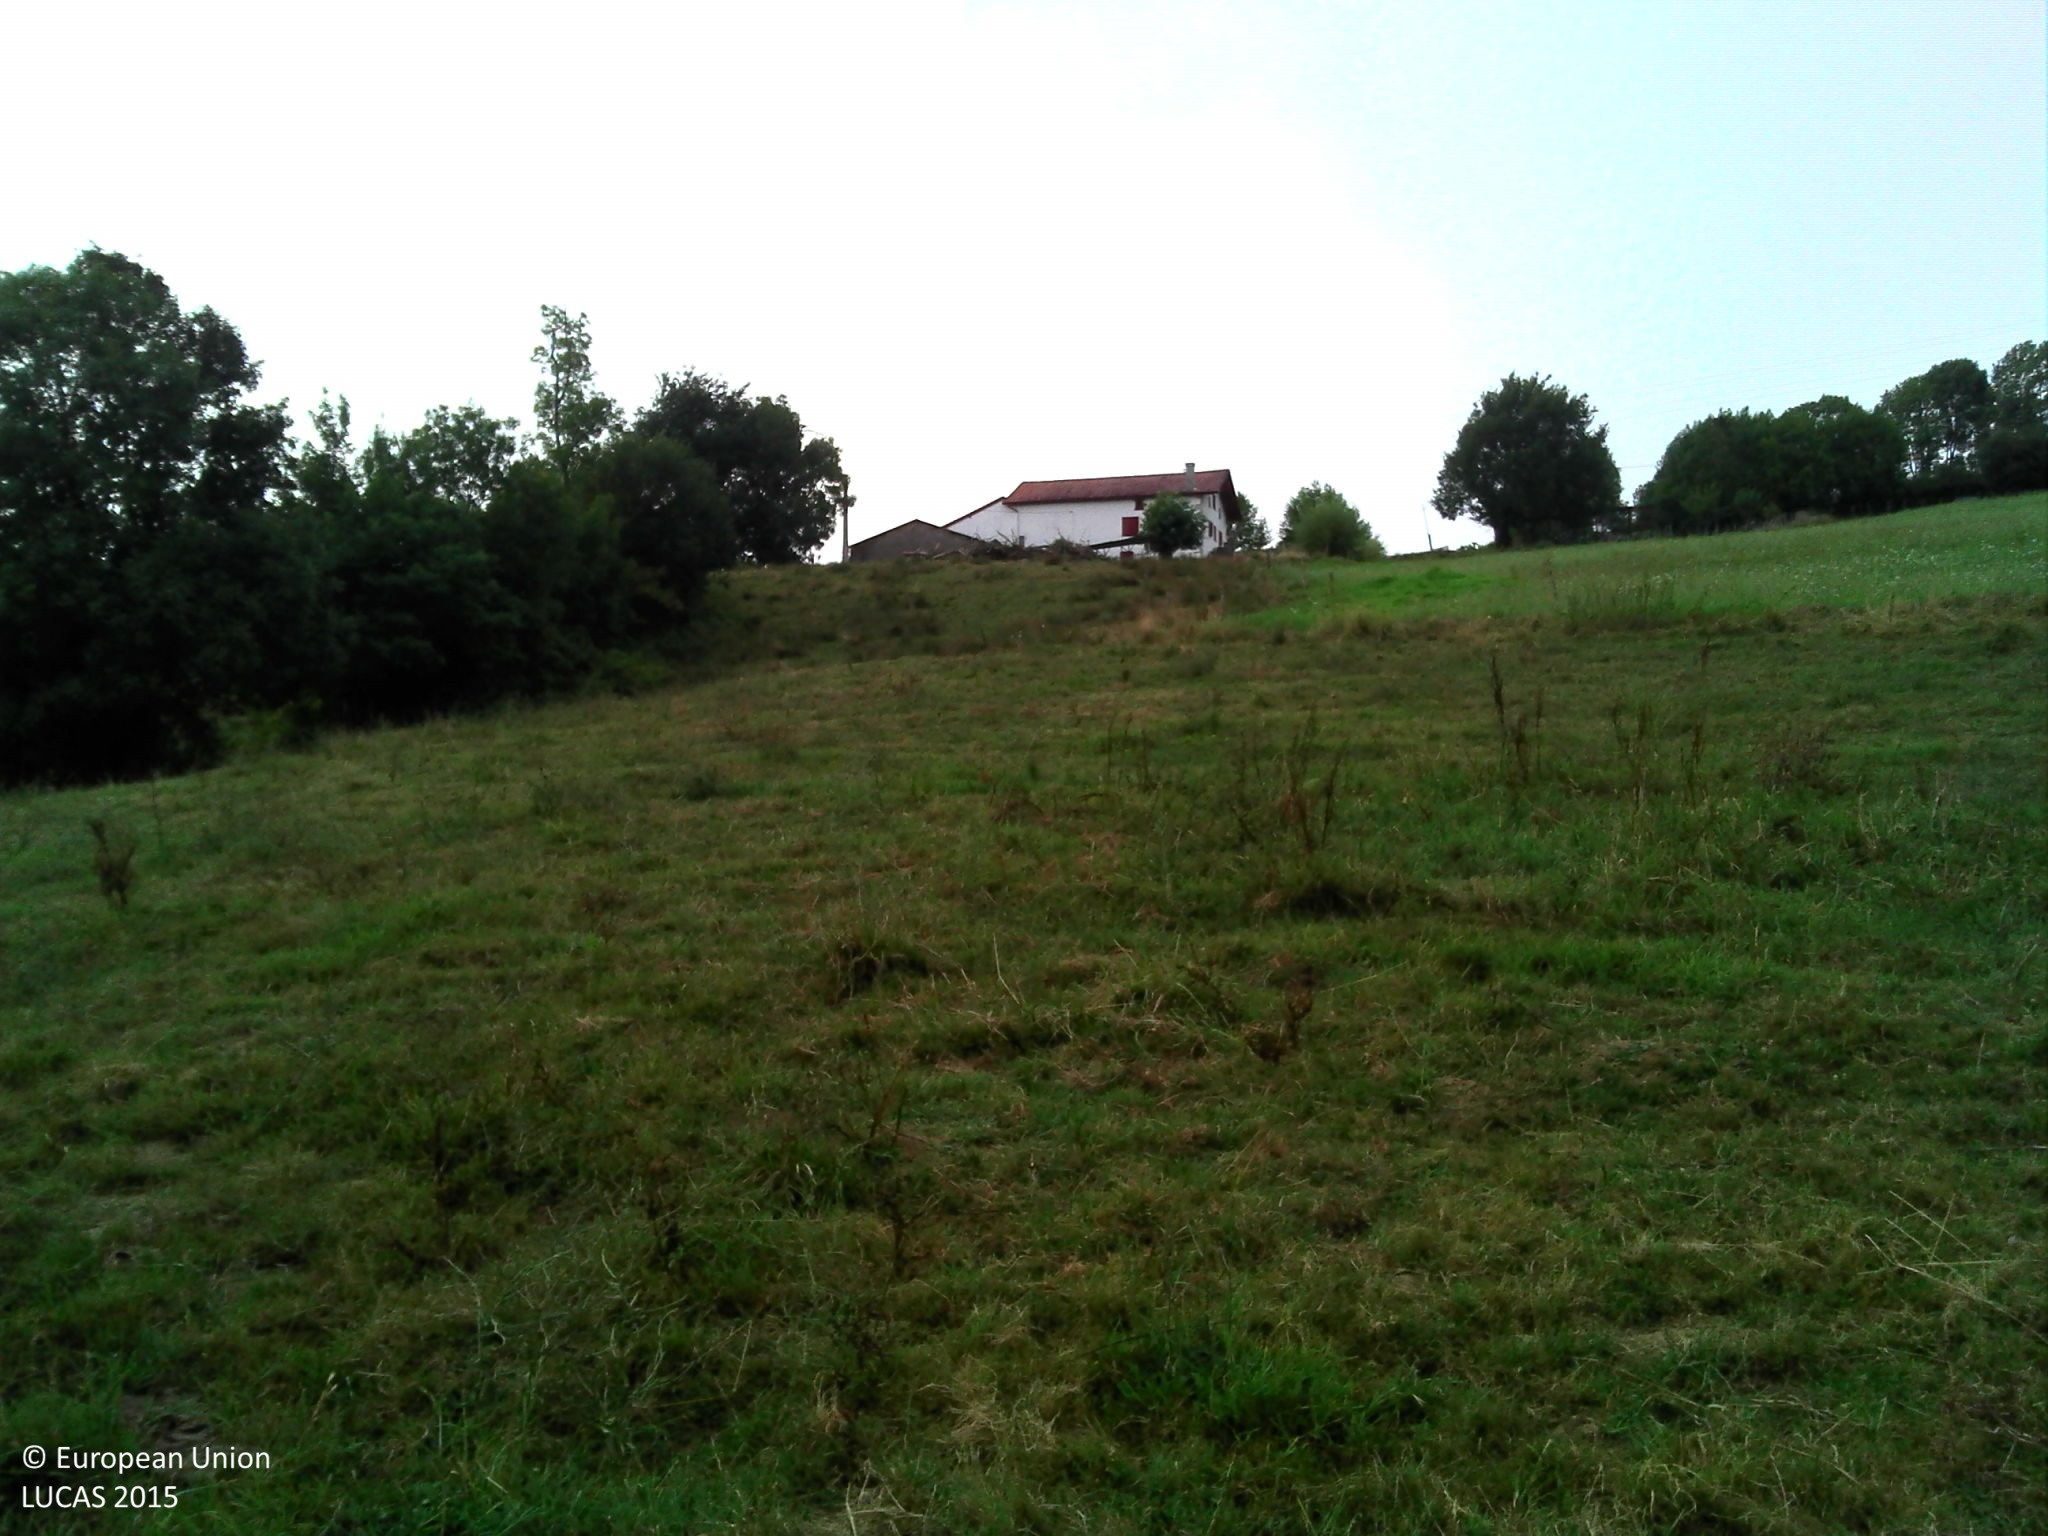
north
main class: Grassland
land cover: Grassland without tree/shrub cover
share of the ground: > 75 %
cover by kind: herbaceous plants 100 %
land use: Agriculture (excluding fallow land and kitchen gardens)
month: August
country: FR
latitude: 43.3951
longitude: -1.2128
